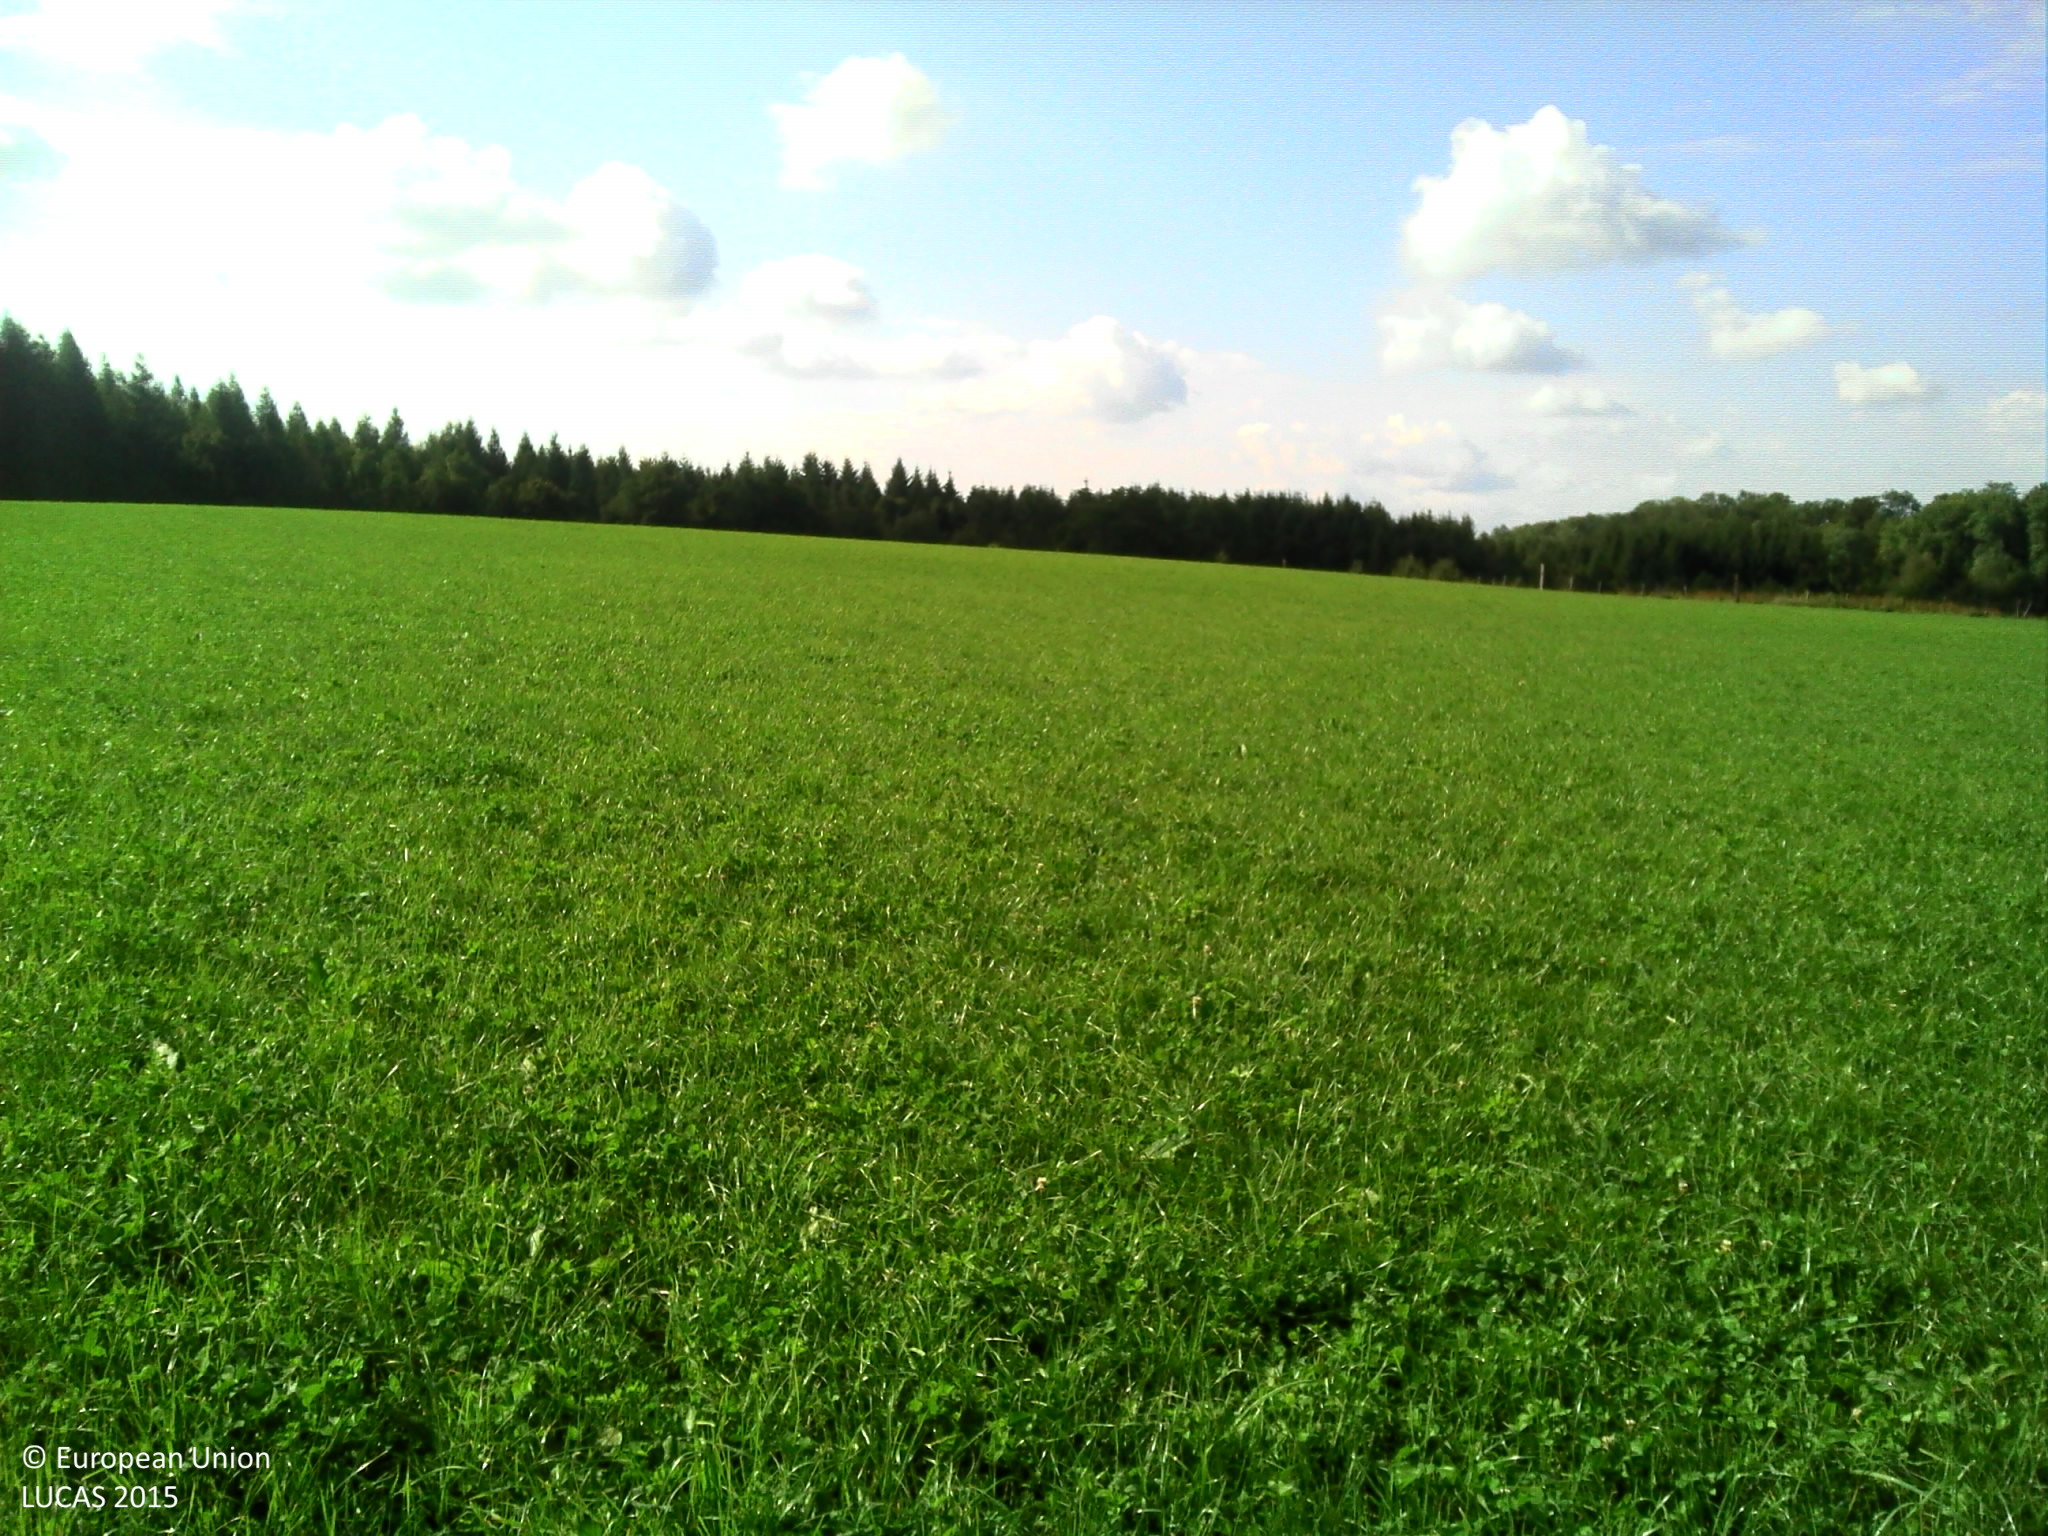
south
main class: Grassland
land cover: Grassland without tree/shrub cover
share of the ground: > 75 %
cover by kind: herbaceous plants 100 %
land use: Agriculture (excluding fallow land and kitchen gardens)
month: September
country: FR
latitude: 47.2090
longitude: 6.3712
